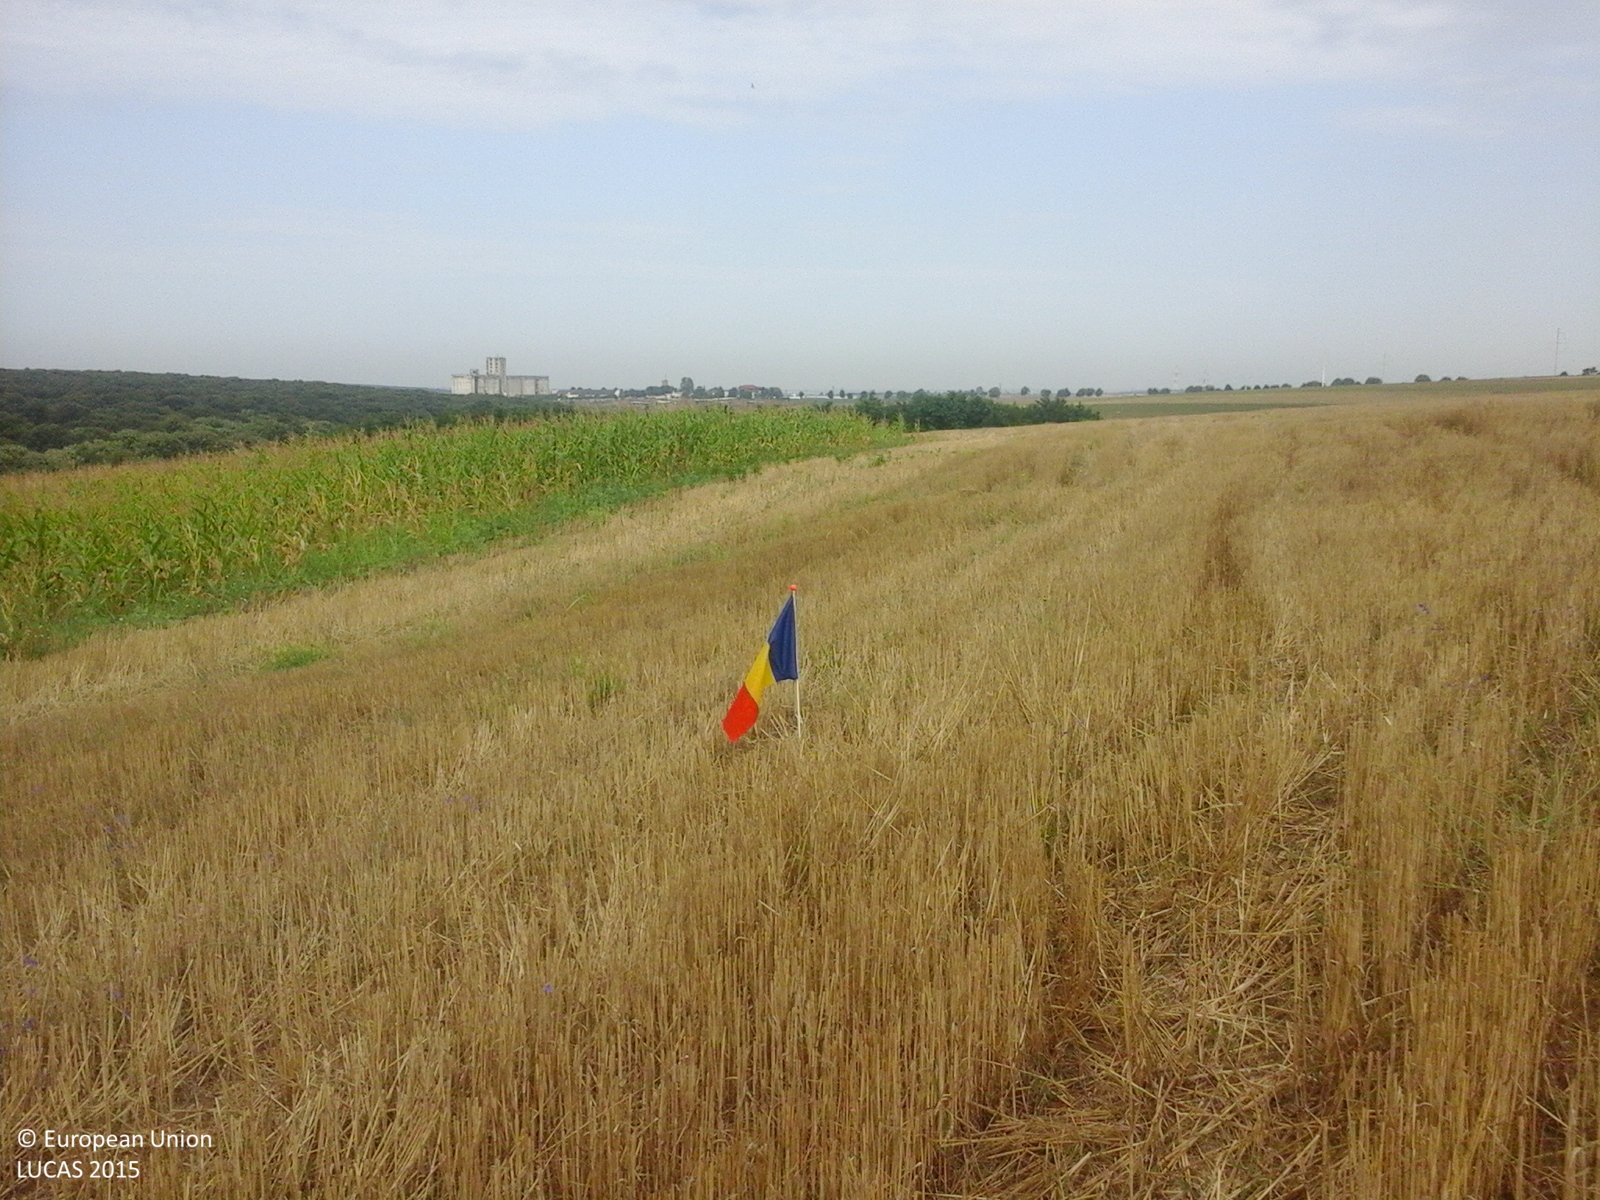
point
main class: Cropland
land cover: Common wheat
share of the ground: > 75 %
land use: Agriculture (excluding fallow land and kitchen gardens)
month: August
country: RO
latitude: 44.0614
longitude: 27.7343
